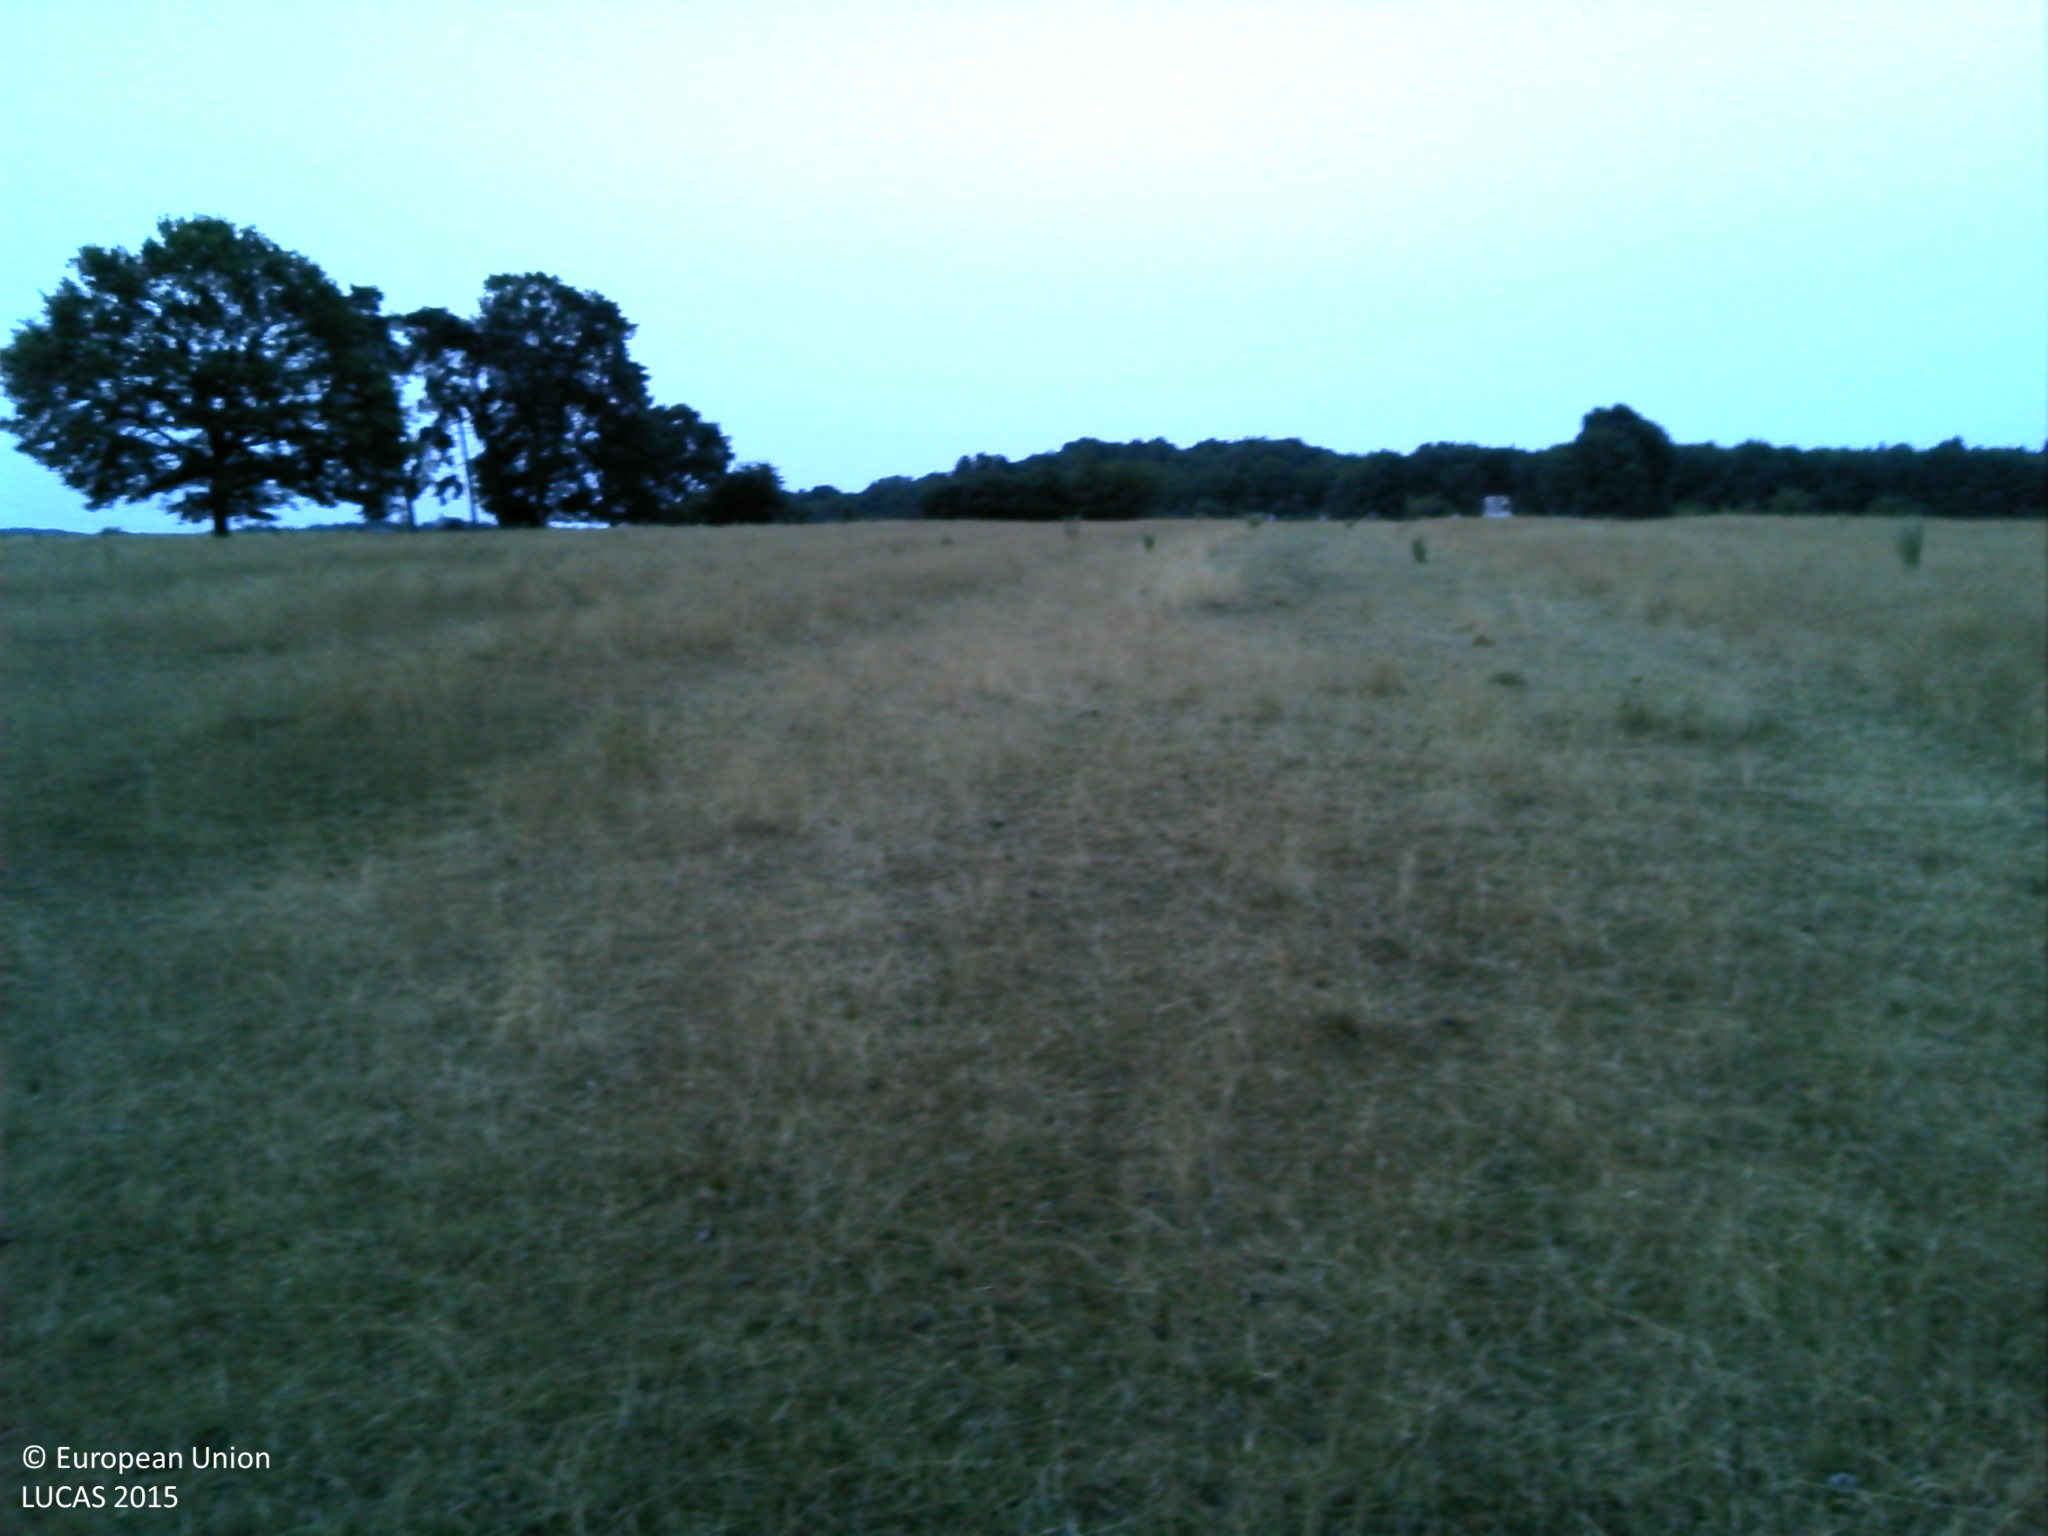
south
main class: Grassland
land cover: Grassland without tree/shrub cover
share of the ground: > 75 %
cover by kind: herbaceous plants 100 %
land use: Agriculture (excluding fallow land and kitchen gardens)
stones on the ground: < 10 %
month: July
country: FR
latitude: 48.2585
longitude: 6.5120
